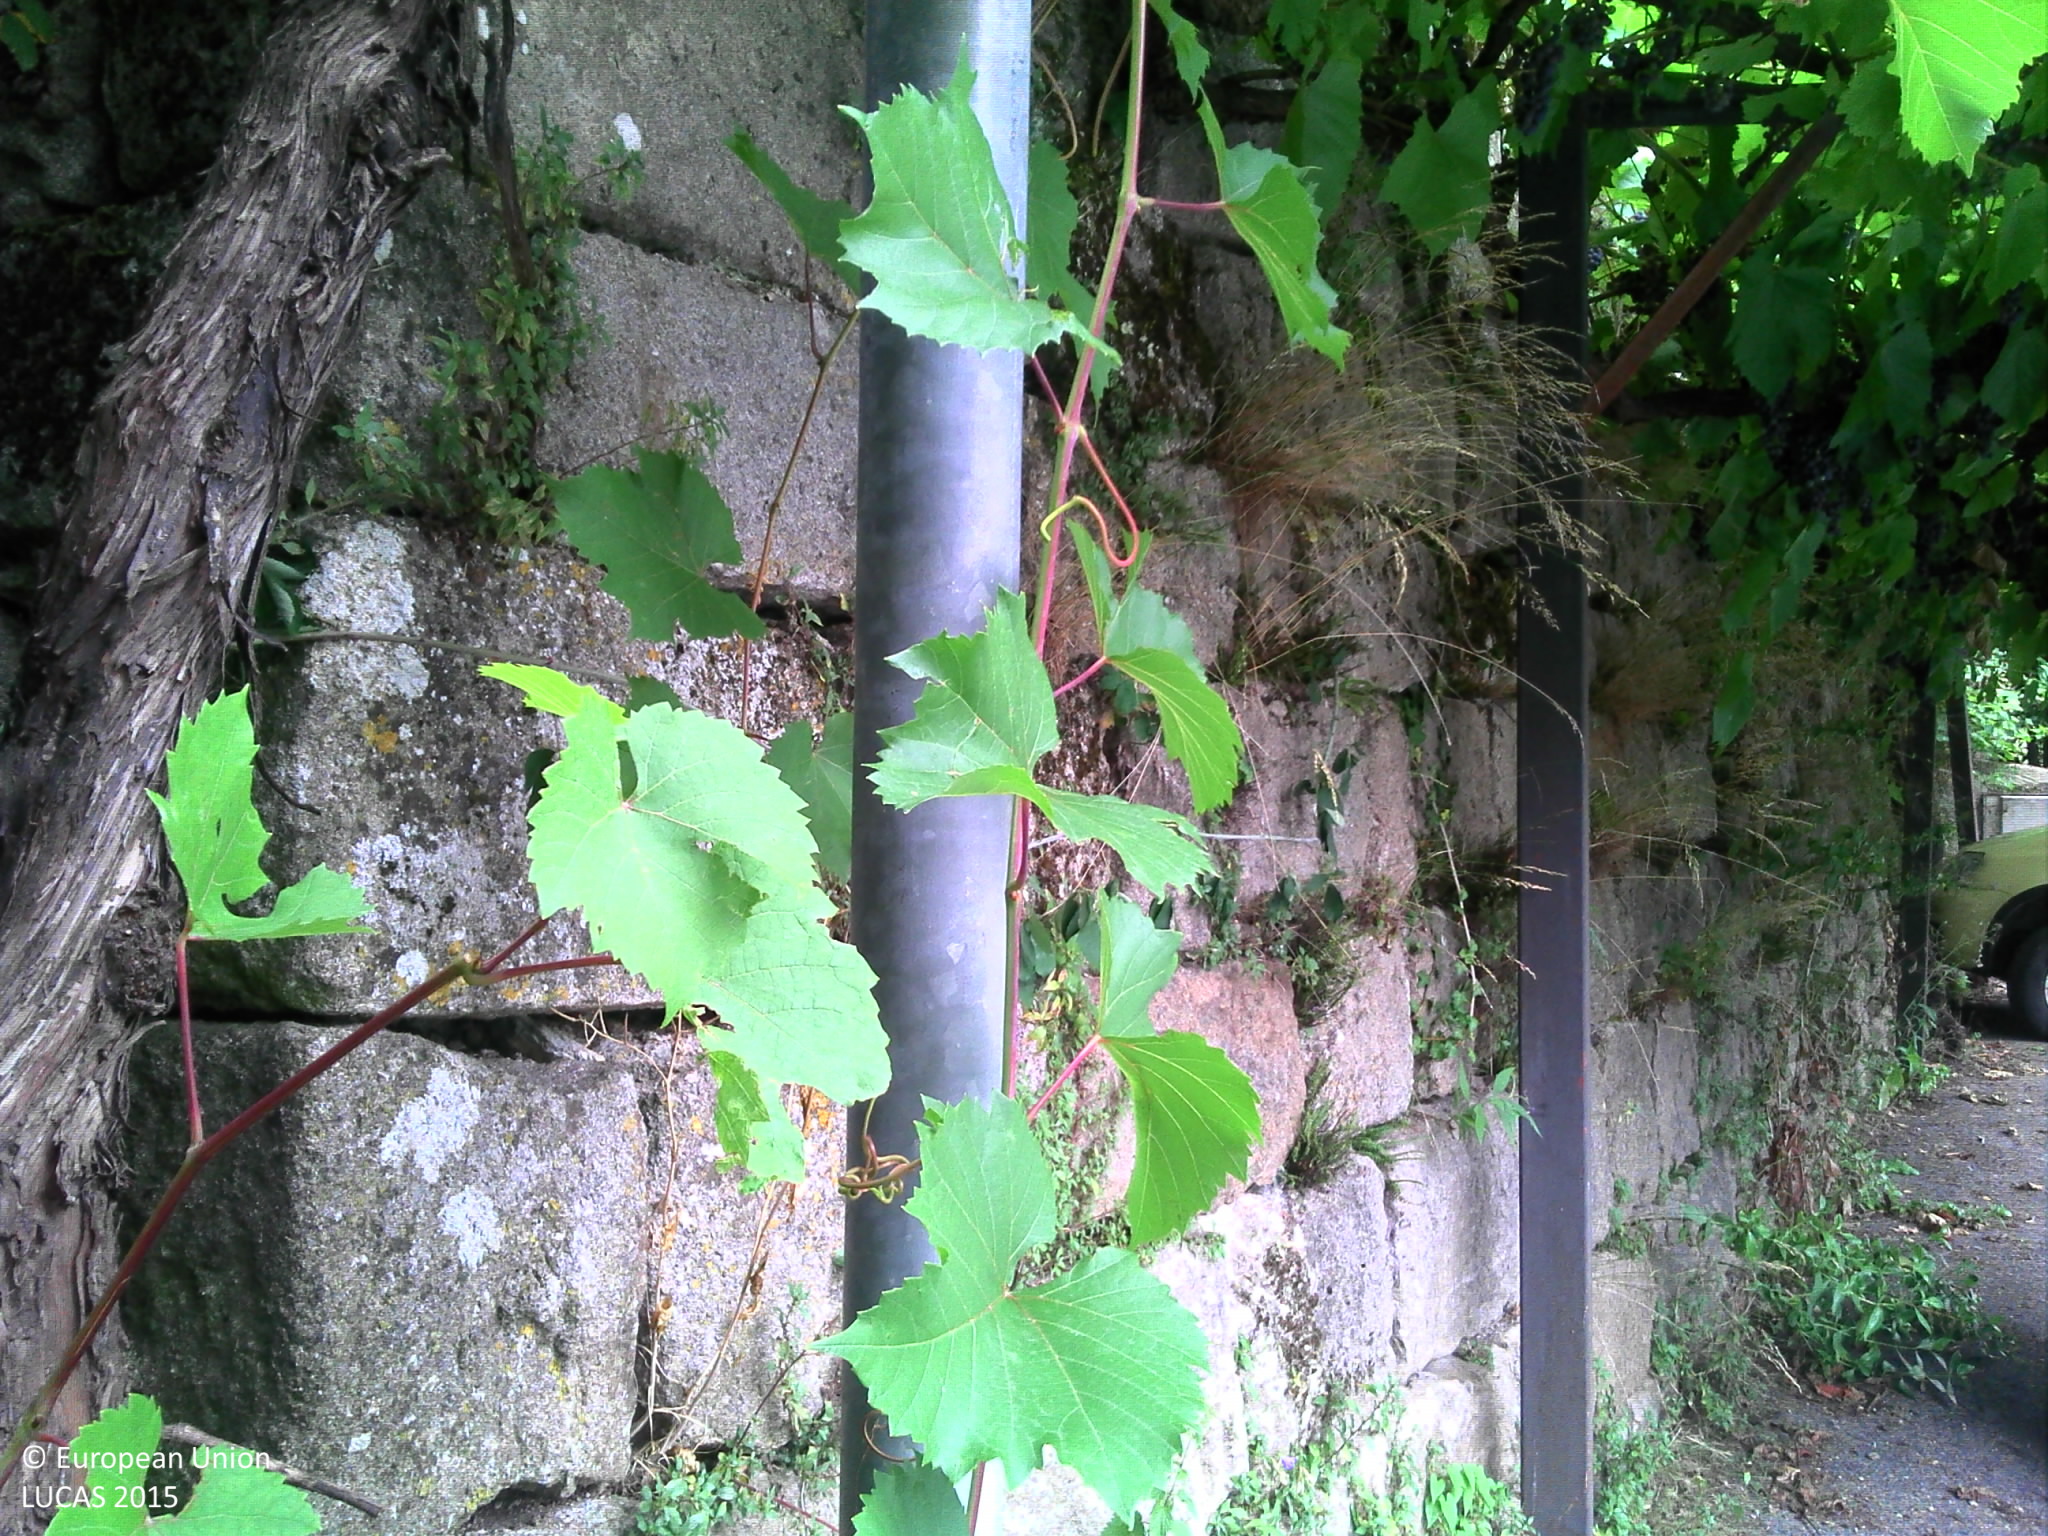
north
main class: Woodland
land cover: Broadleaved woodland
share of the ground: > 75 %
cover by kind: broadleaved forest trees 90 %, herbaceous plants 10 %
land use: Residential
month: August
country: FR
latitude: 44.8772
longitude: 4.5750
